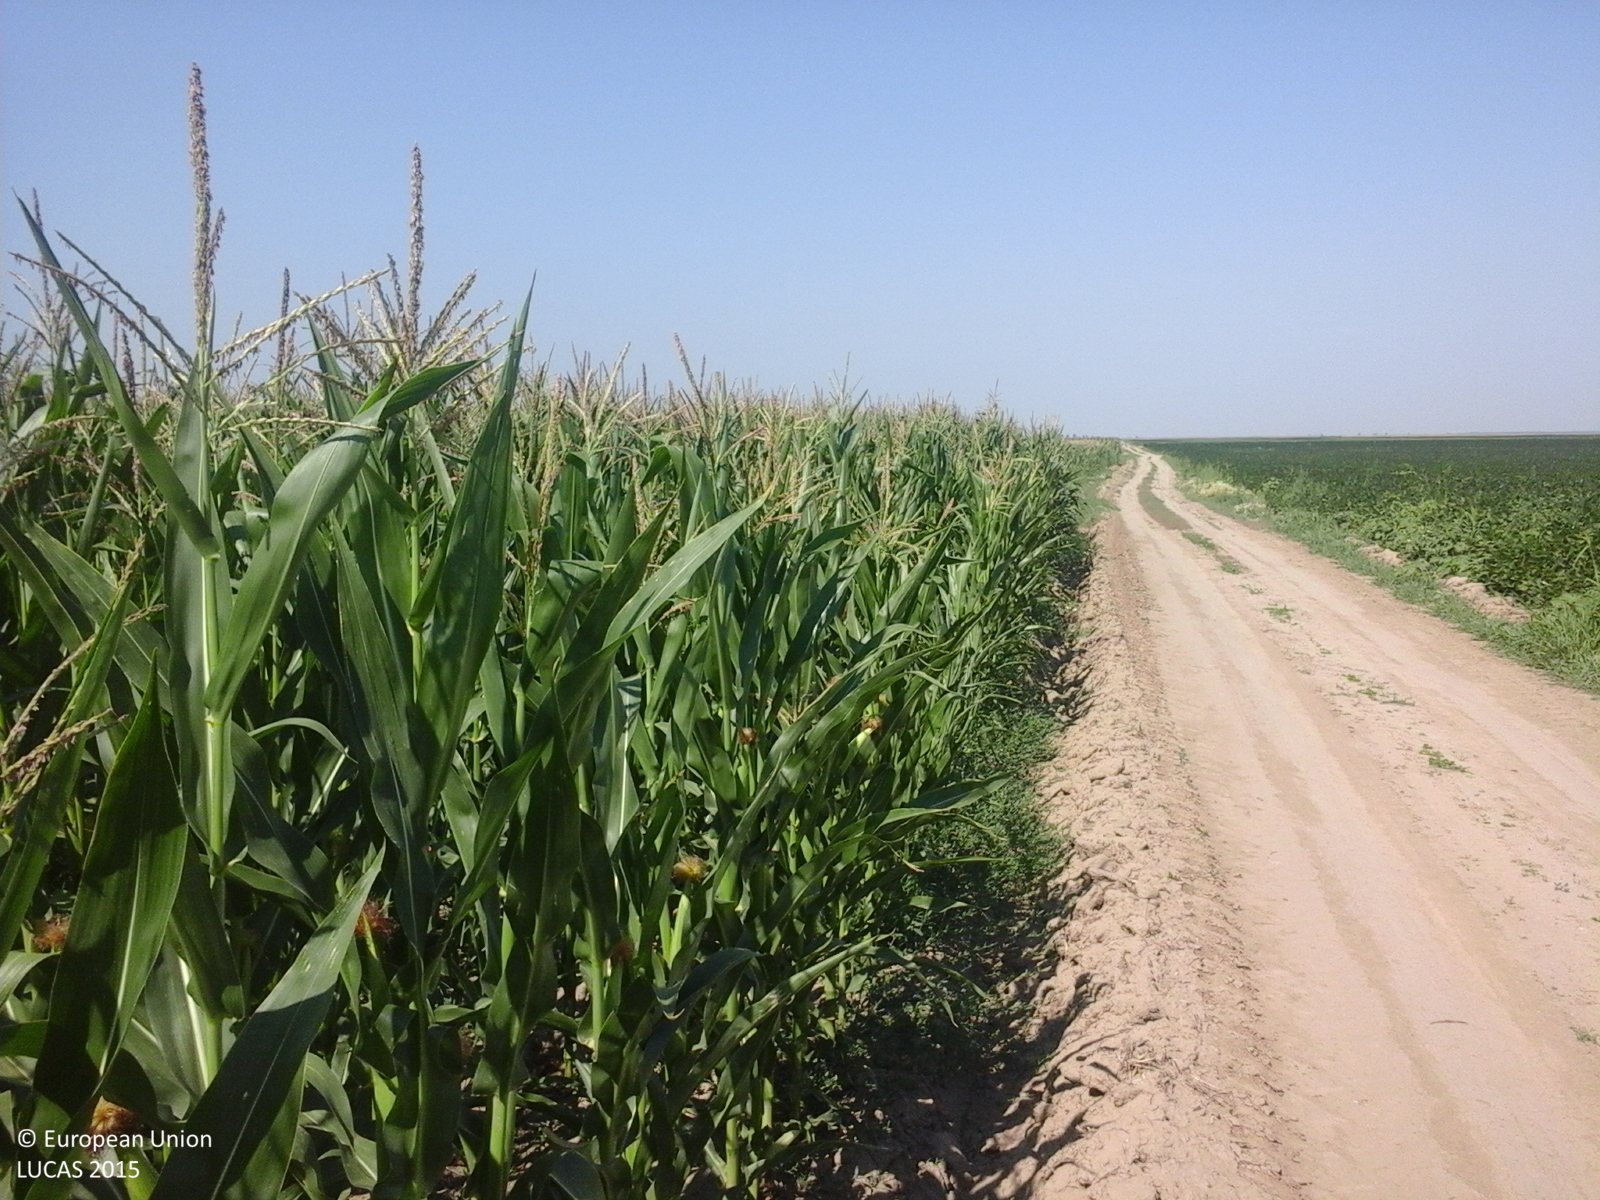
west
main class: Cropland
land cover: Maize
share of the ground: > 75 %
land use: Agriculture (excluding fallow land and kitchen gardens)
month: July
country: RO
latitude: 44.1606
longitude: 27.0451
